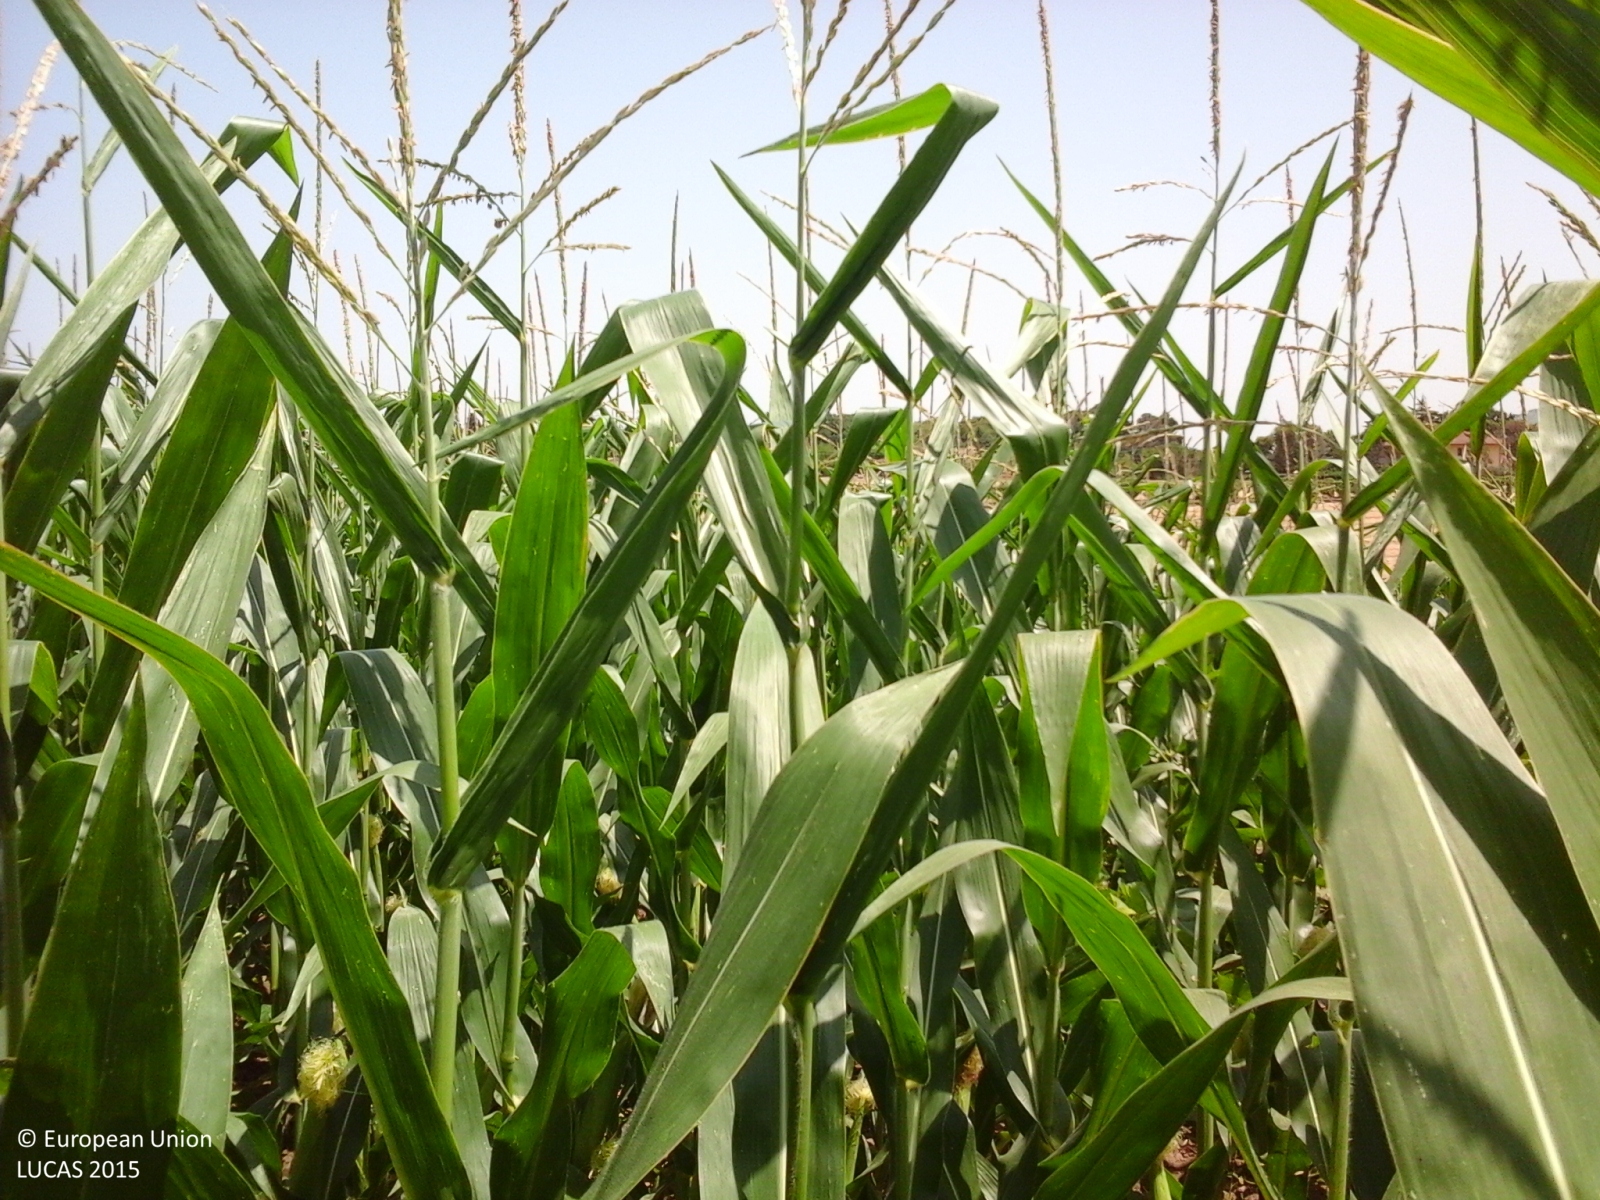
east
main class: Cropland
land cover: Maize
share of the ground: > 75 %
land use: Agriculture (excluding fallow land and kitchen gardens)
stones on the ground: < 10 %
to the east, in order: Maize; Durum wheat; Tracks; Durum wheat; Vineyards; Durum wheat; Artificial constructions in urban areas; Durum wheat
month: July
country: IT
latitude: 43.3703
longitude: 13.5084
